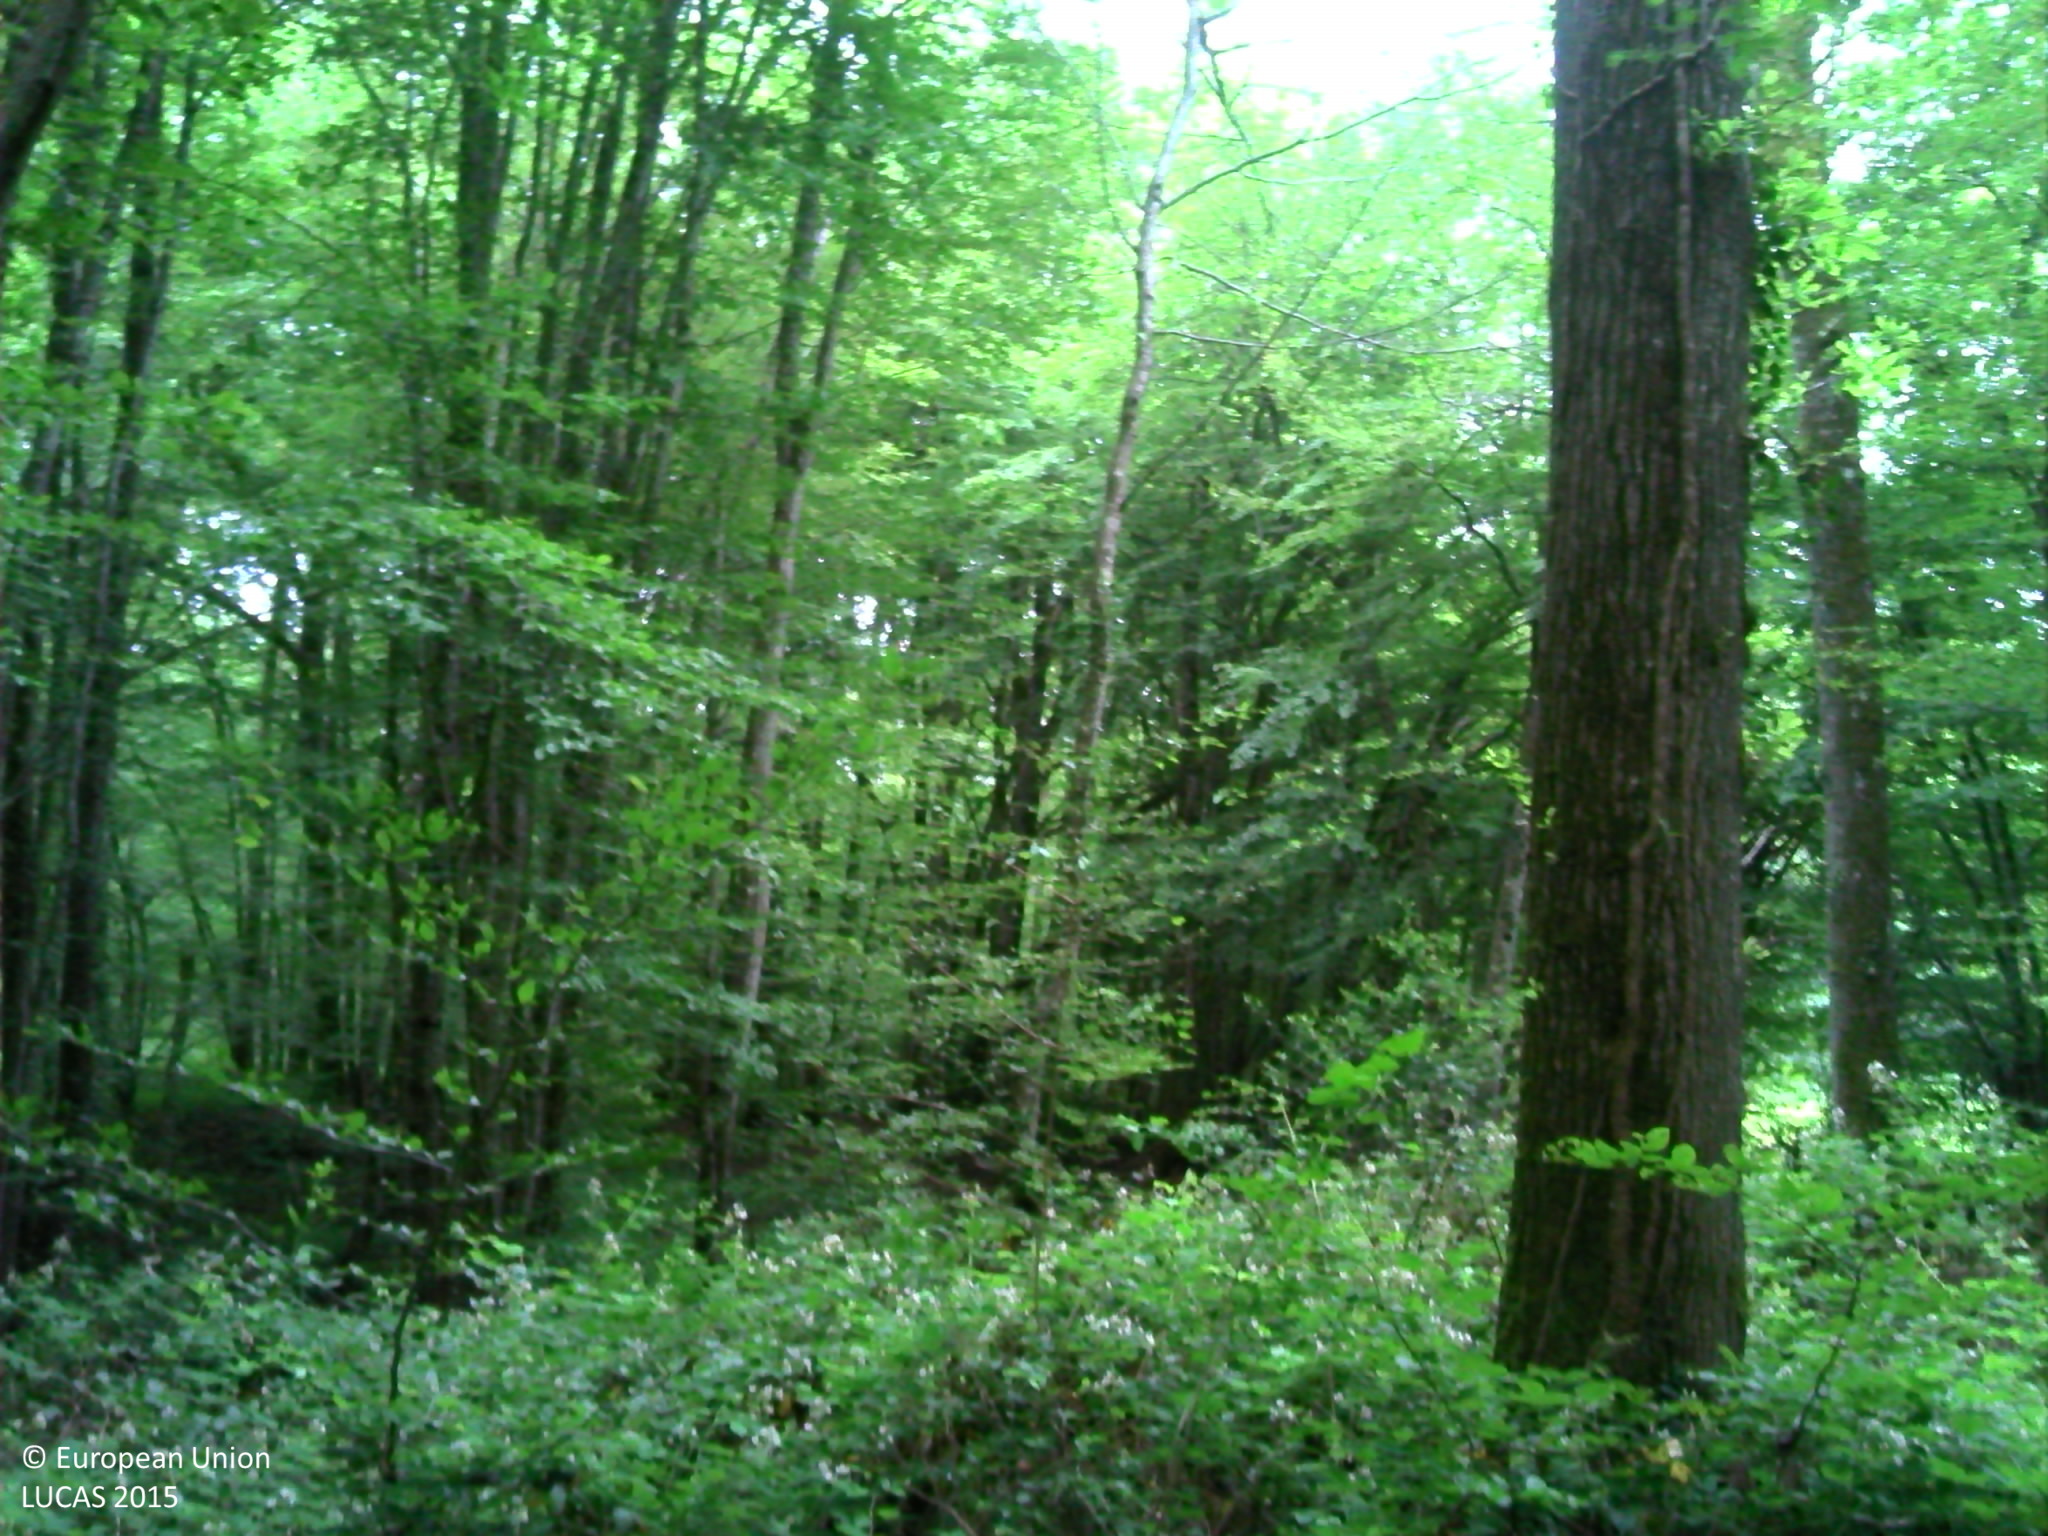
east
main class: Woodland
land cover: Broadleaved woodland
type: mesophytic deciduous forest
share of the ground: > 75 %
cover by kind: broadleaved forest trees 100 %
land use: Forestry
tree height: > 5 m
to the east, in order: Broadleaved woodland
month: June
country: FR
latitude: 47.5556
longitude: 3.0974
